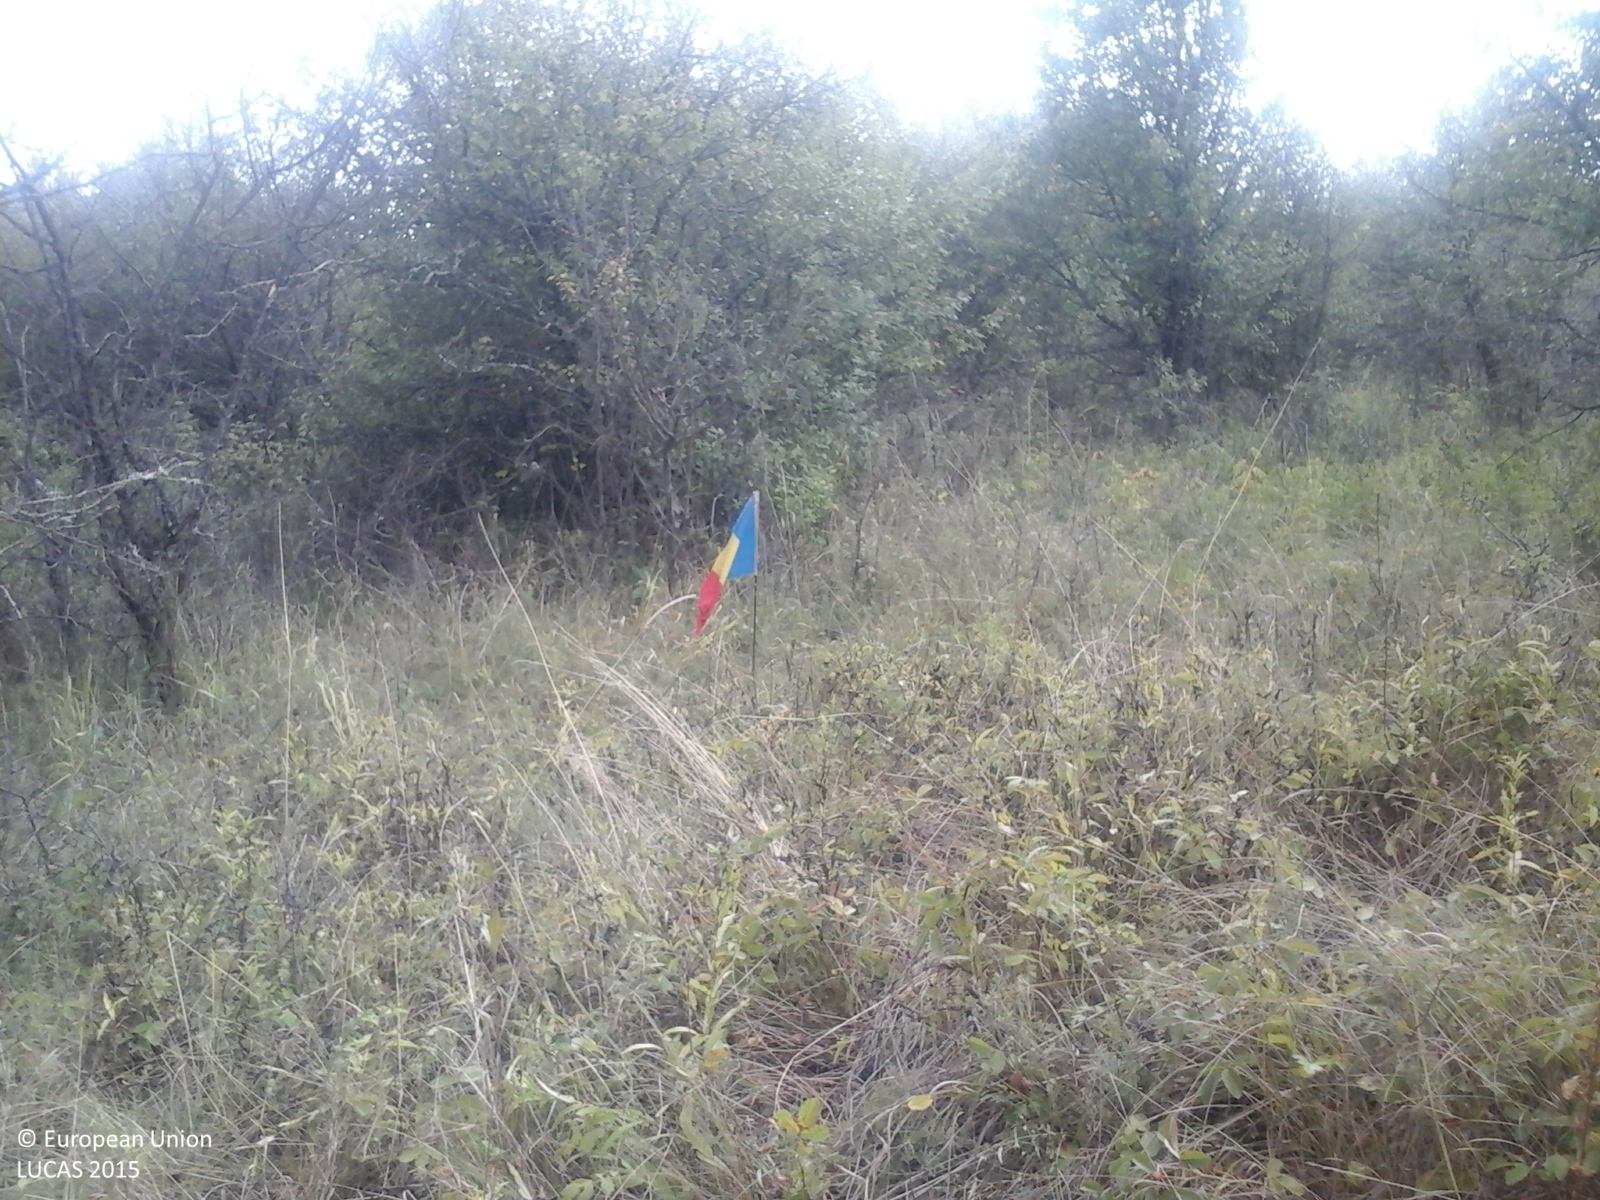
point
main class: Shrubland
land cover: Shrubland with sparse tree cover
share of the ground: 25 - 50 %
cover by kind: herbaceous plants 60 %, shrubs 35 %, broadleaved forest trees 5 %
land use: Abandoned areas
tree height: < 5 m
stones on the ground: < 10 %
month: August
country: RO
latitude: 45.8971
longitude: 21.6229
